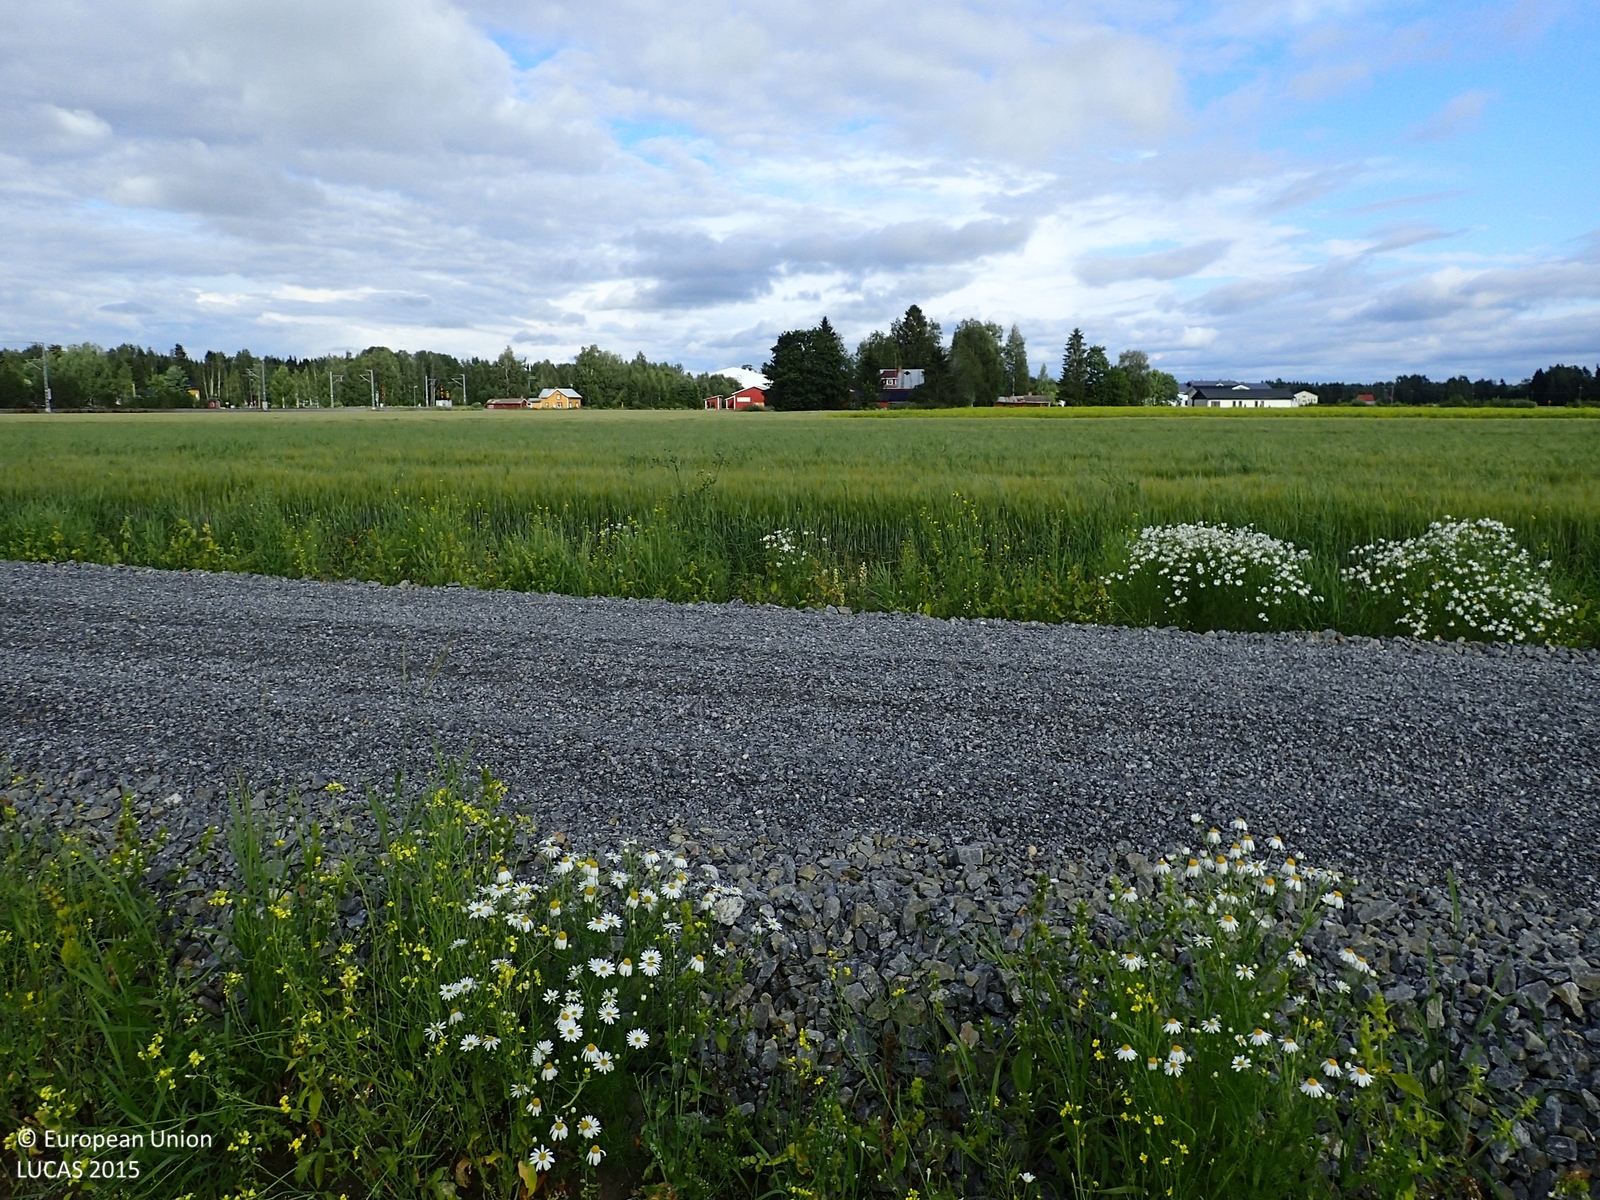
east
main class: Cropland
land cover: Common wheat
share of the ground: > 75 %
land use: Agriculture (excluding fallow land and kitchen gardens)
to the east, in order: Common wheat; Shruby margins; Ditches and canals; Shruby margins; Paved roads, cycling and walking lanes; Shruby margins; Ditches and canals; Barley
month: July
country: FI
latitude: 62.9909
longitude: 21.9863
